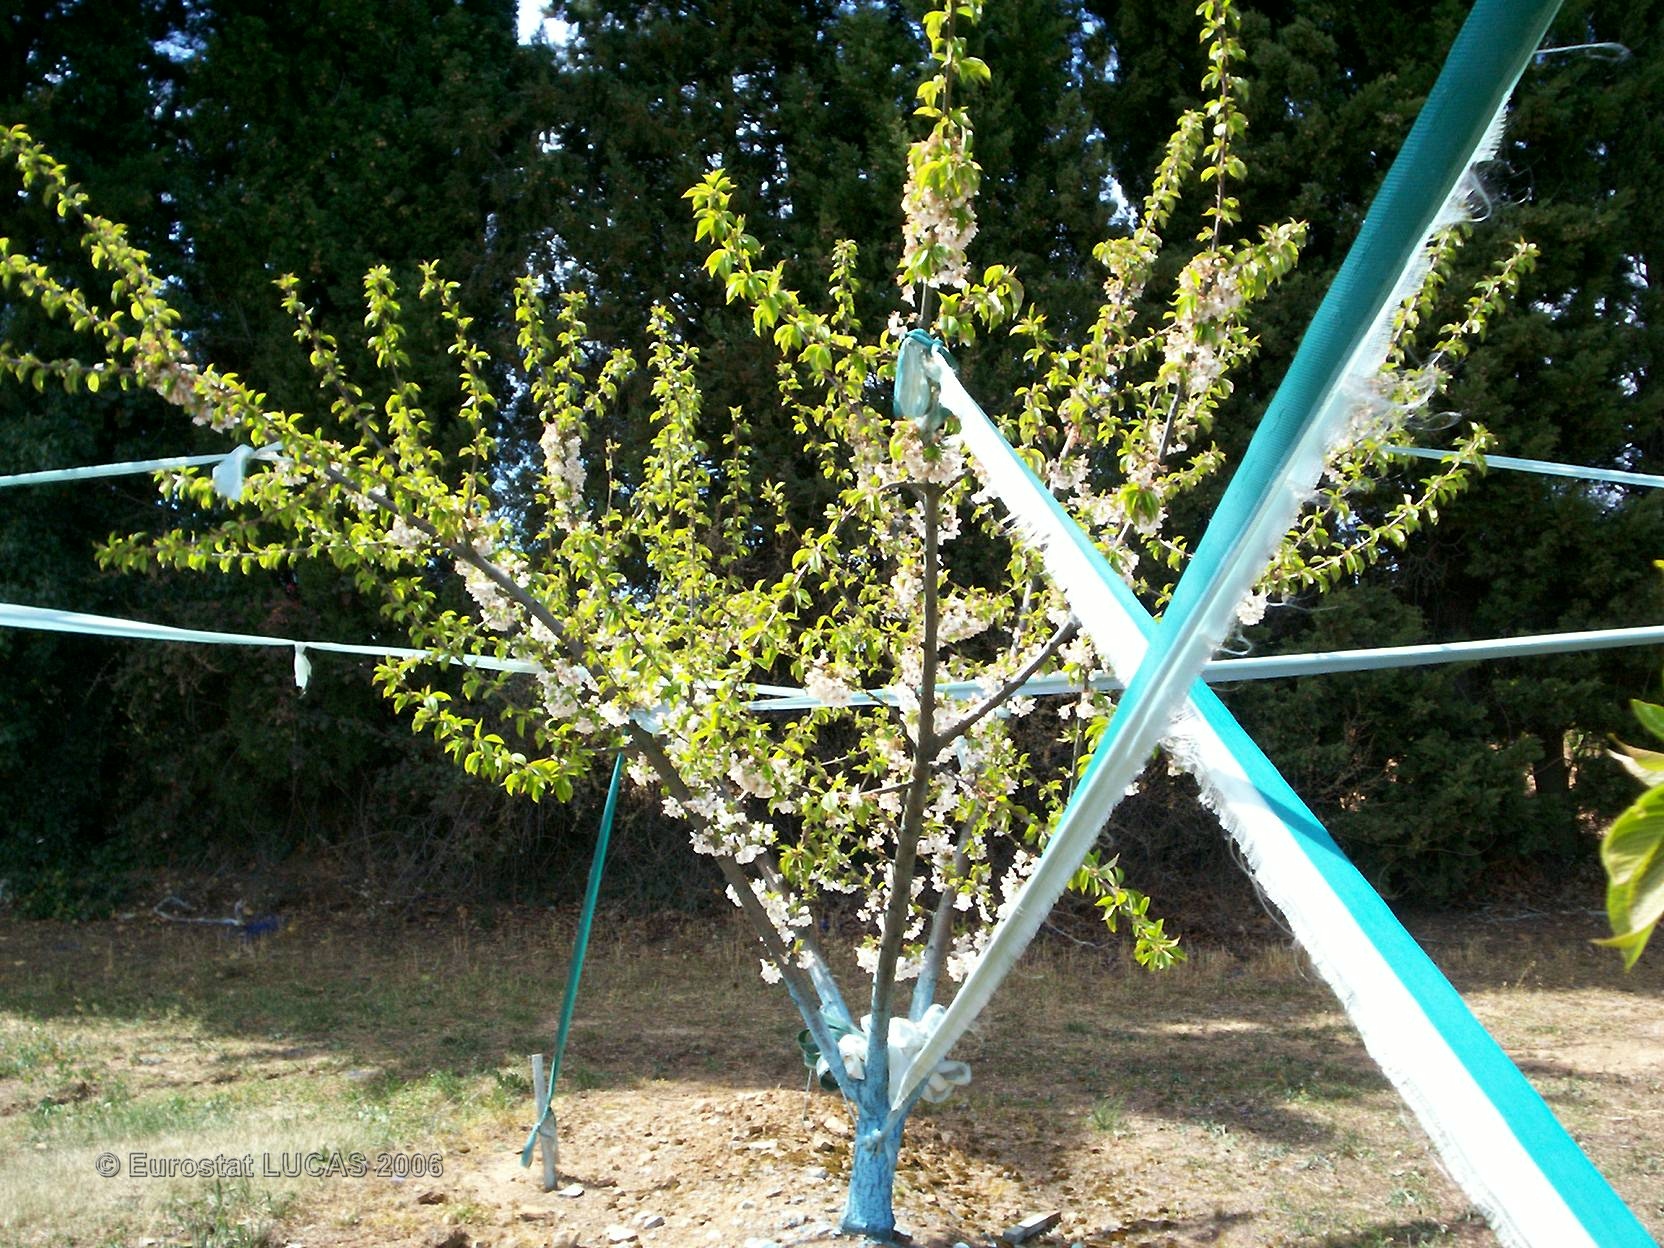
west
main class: Cropland
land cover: Cherry fruit
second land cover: Grassland with sparse tree/shrub cover
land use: Agriculture (excluding fallow land and kitchen gardens)
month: April
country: FR
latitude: 43.6872
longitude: 4.9850
